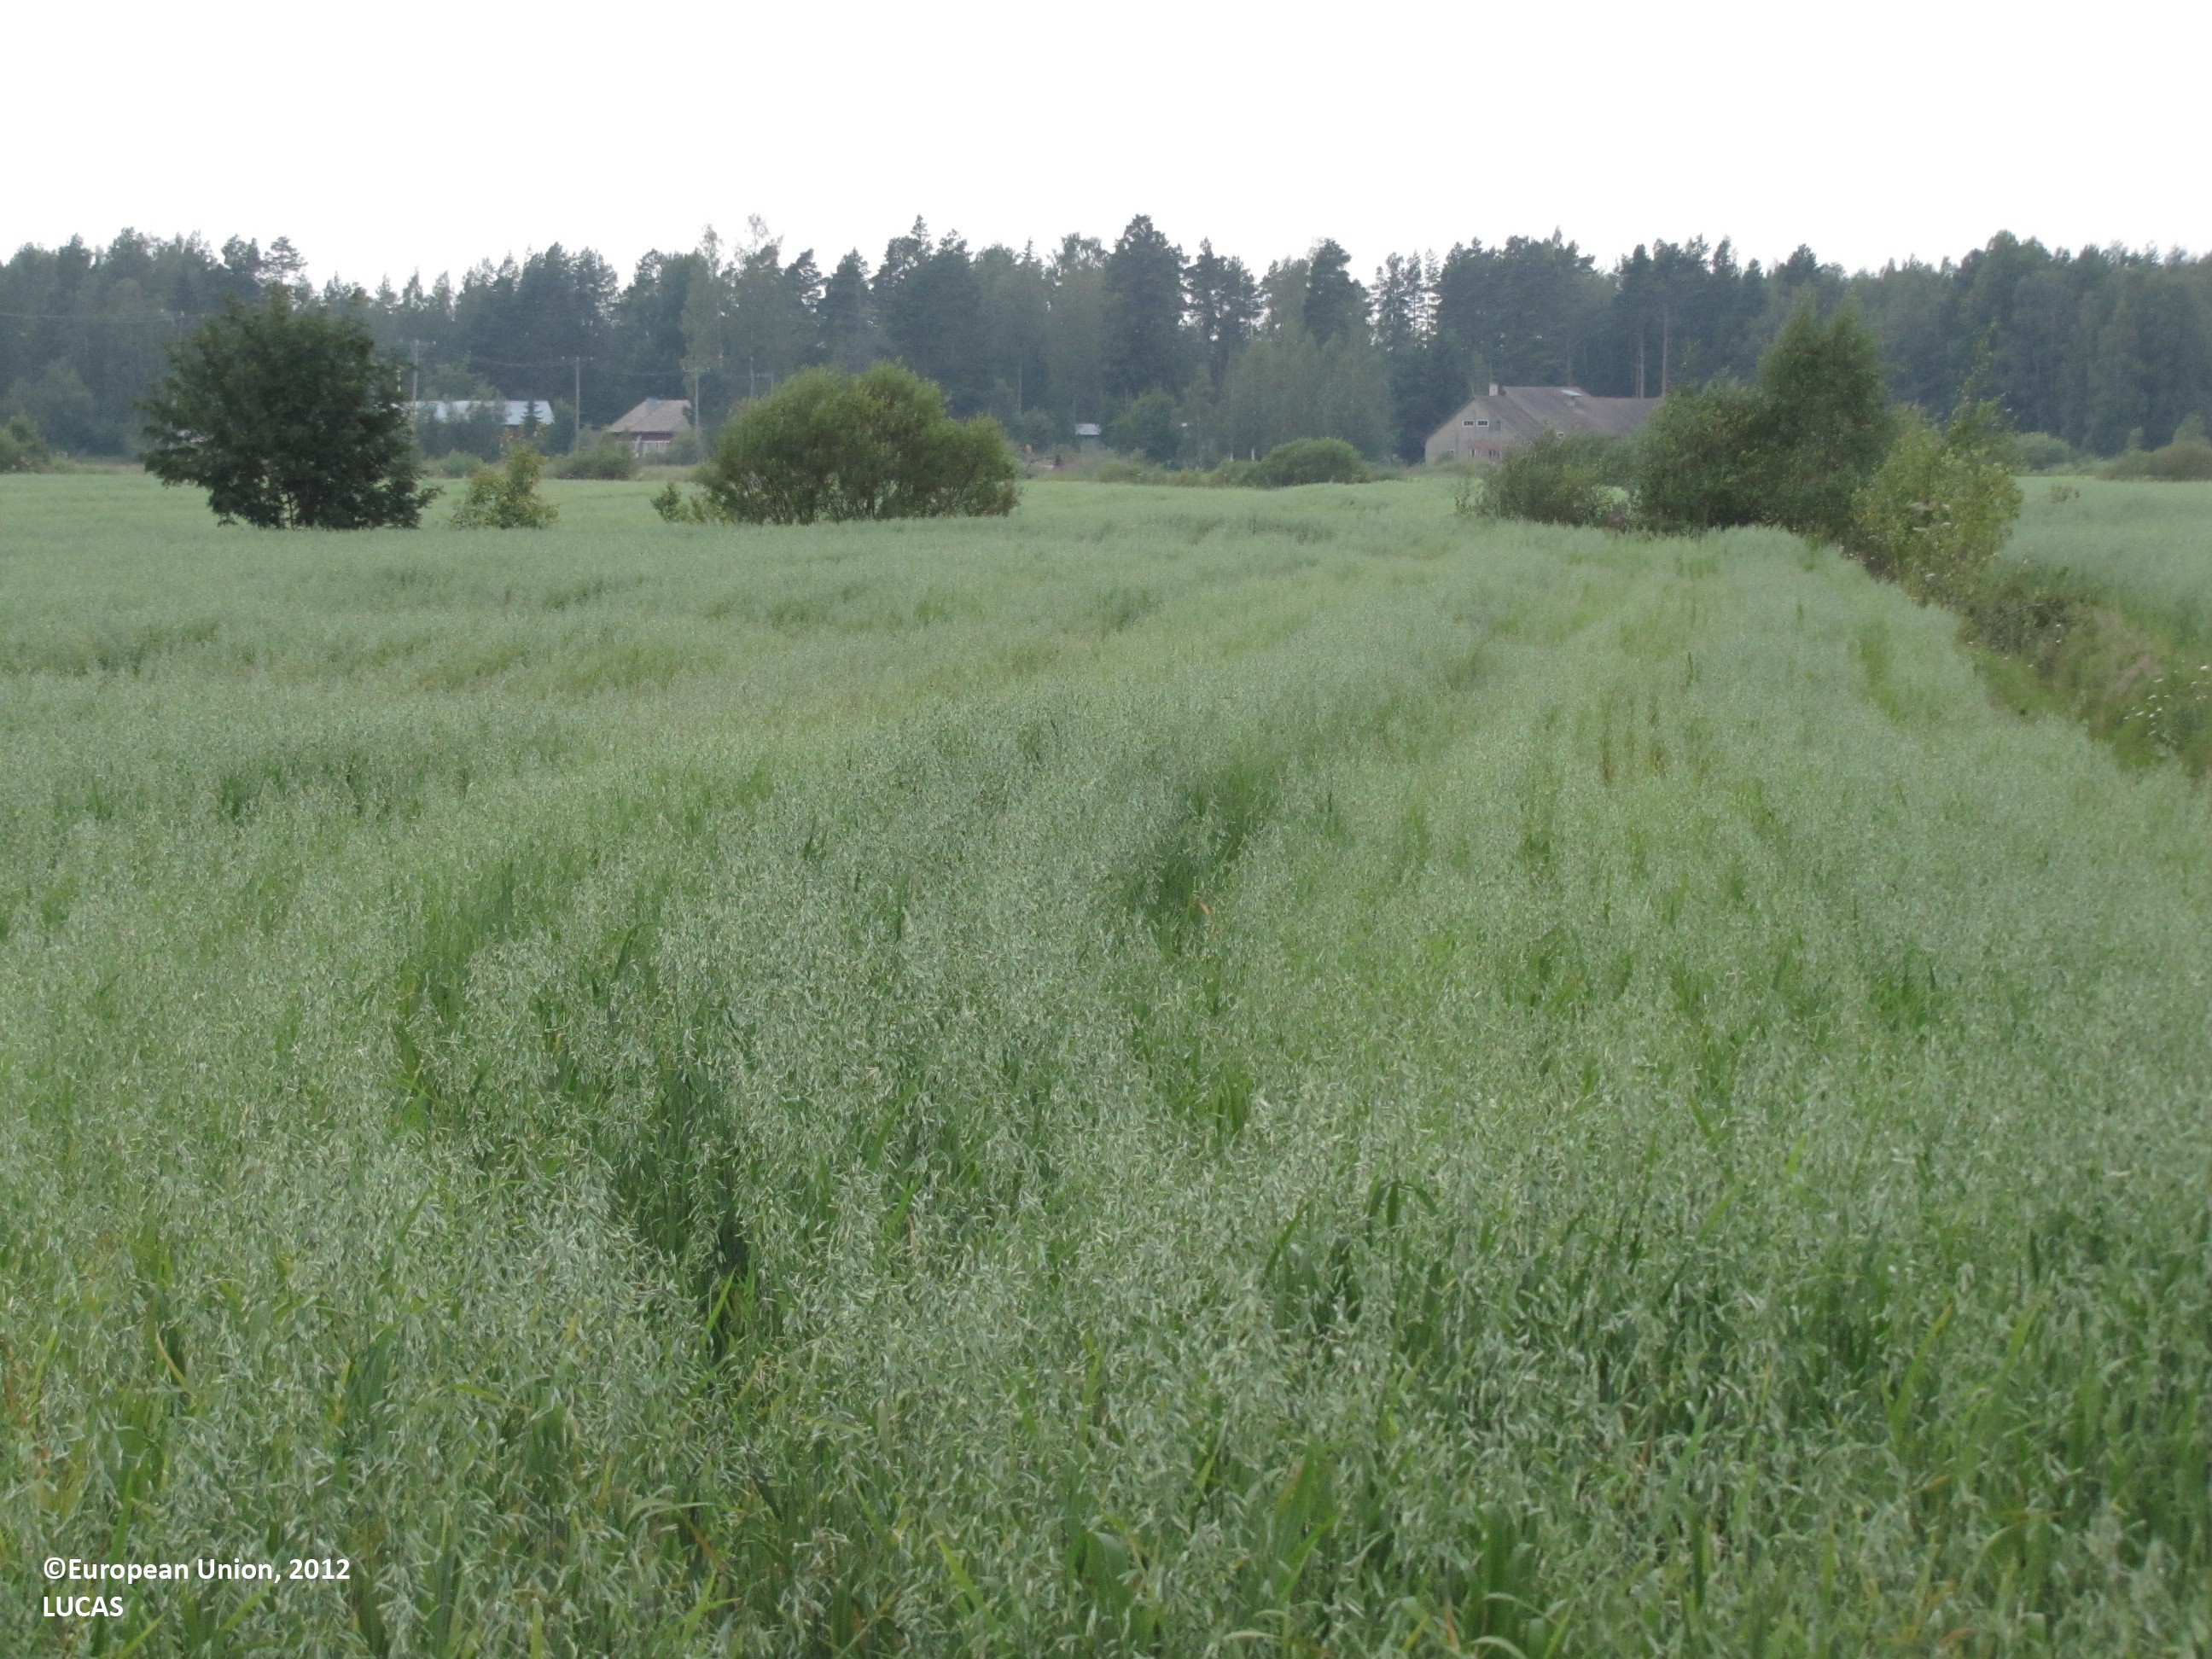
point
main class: Cropland
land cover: Oats
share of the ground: > 75 %
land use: Agriculture (excluding fallow land and kitchen gardens)
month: July
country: FI
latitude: 61.9950
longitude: 22.9526
